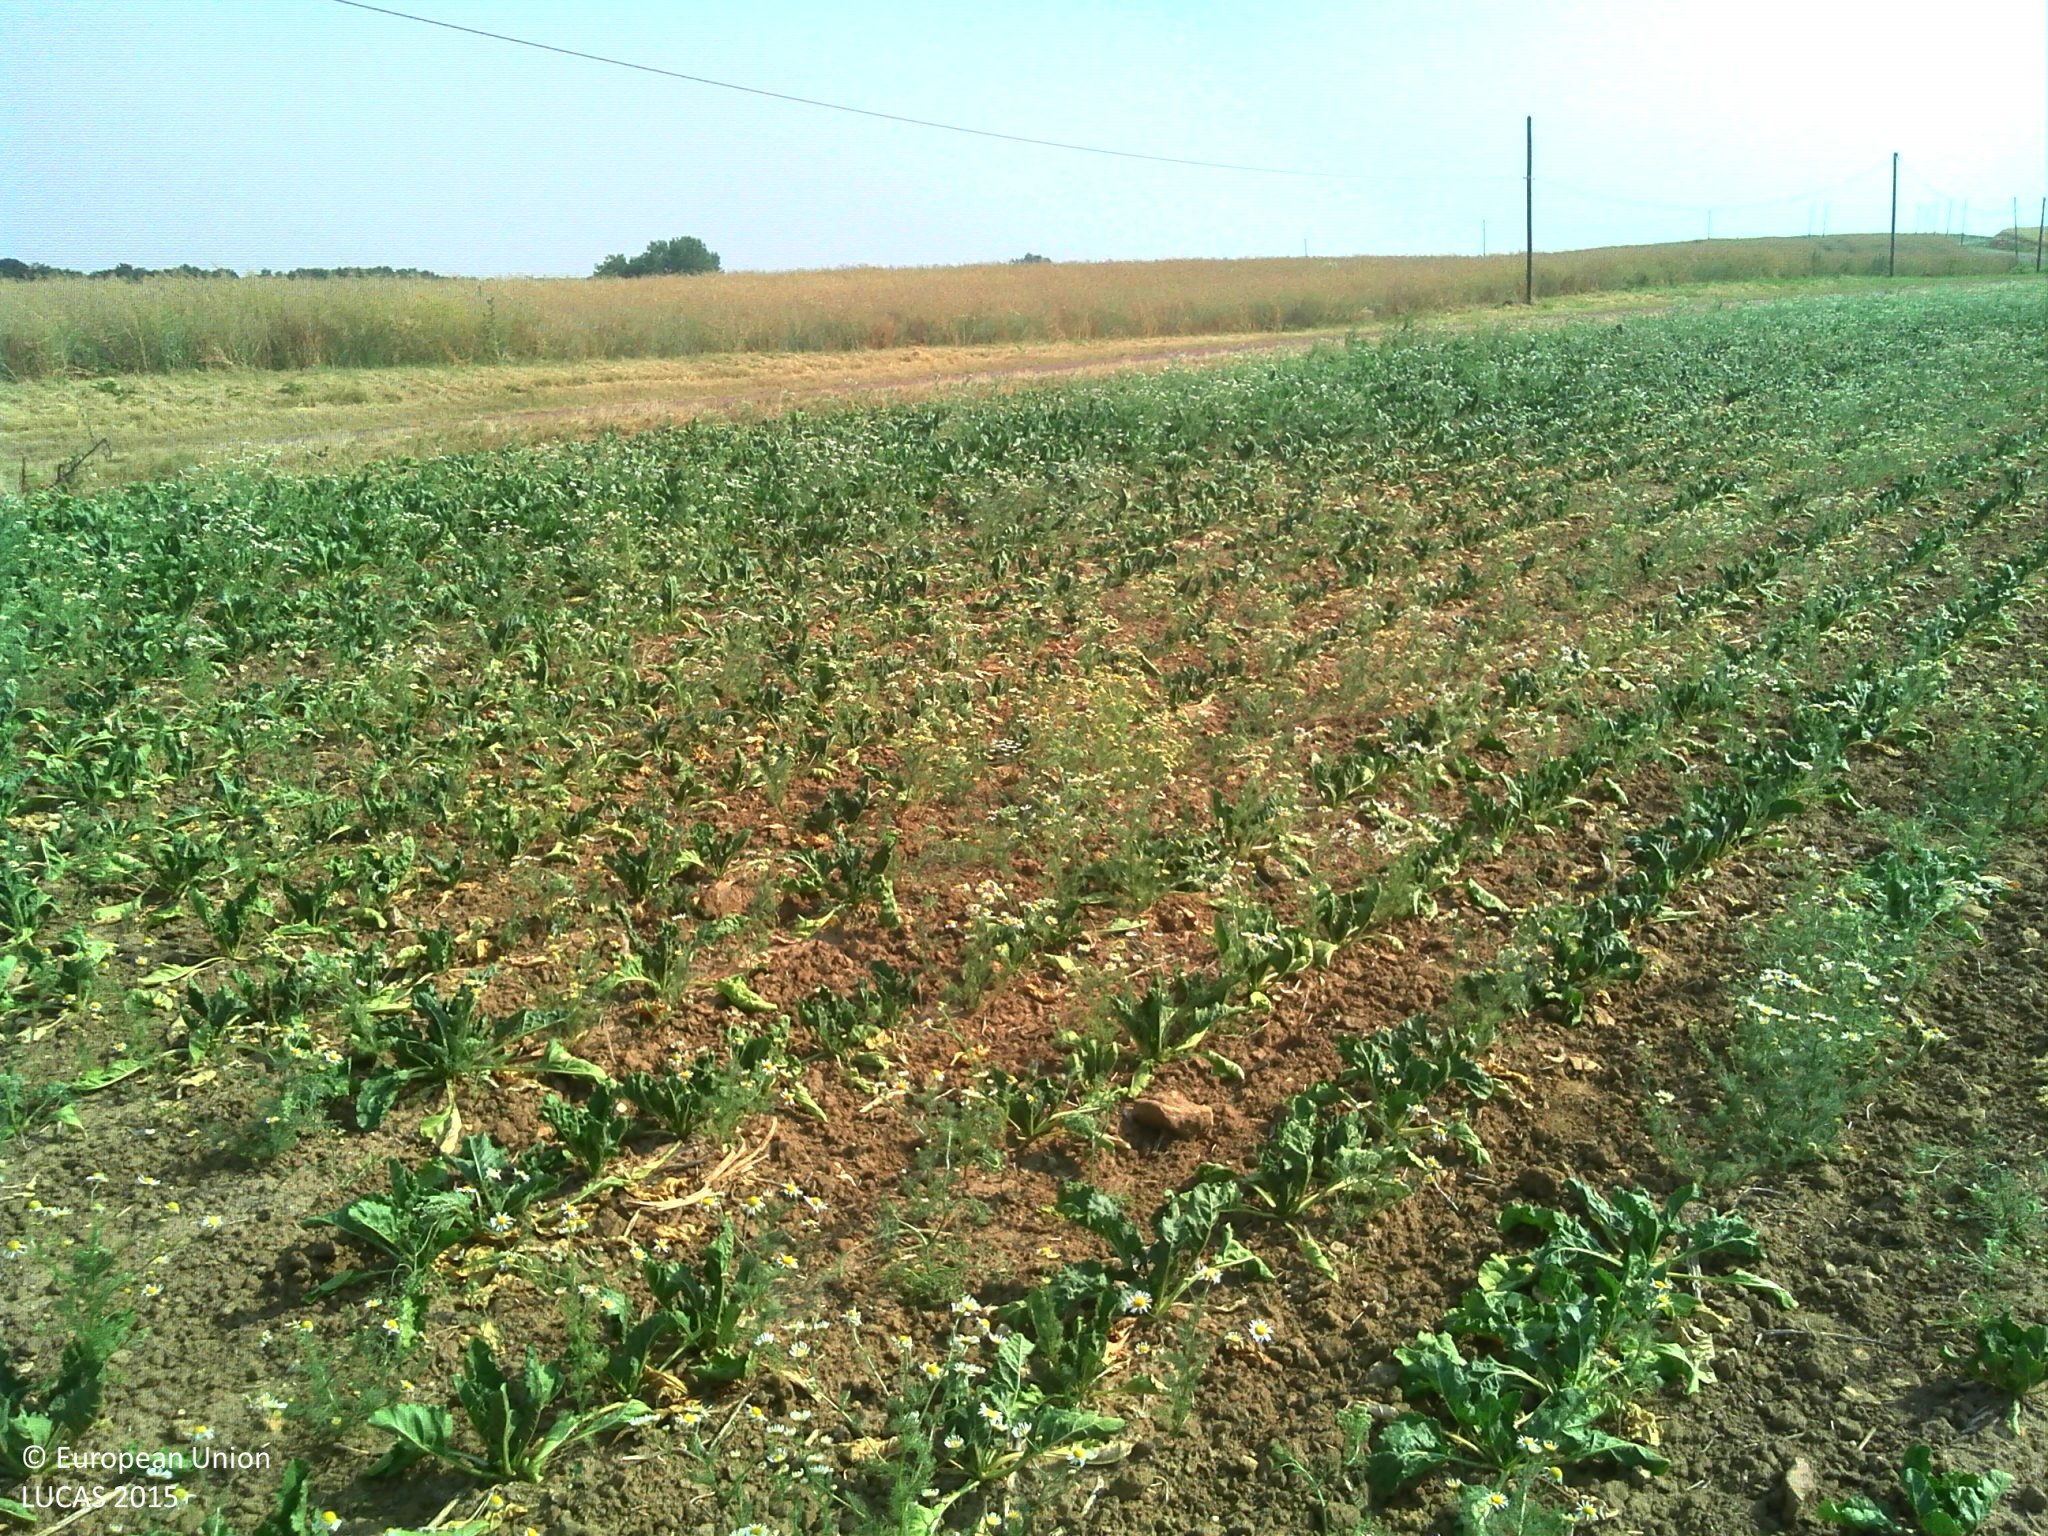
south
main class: Cropland
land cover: Sugar beet
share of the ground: 50 - 75 %
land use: Agriculture (excluding fallow land and kitchen gardens)
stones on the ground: < 10 %
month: July
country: FR
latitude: 49.1595
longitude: 3.3418
